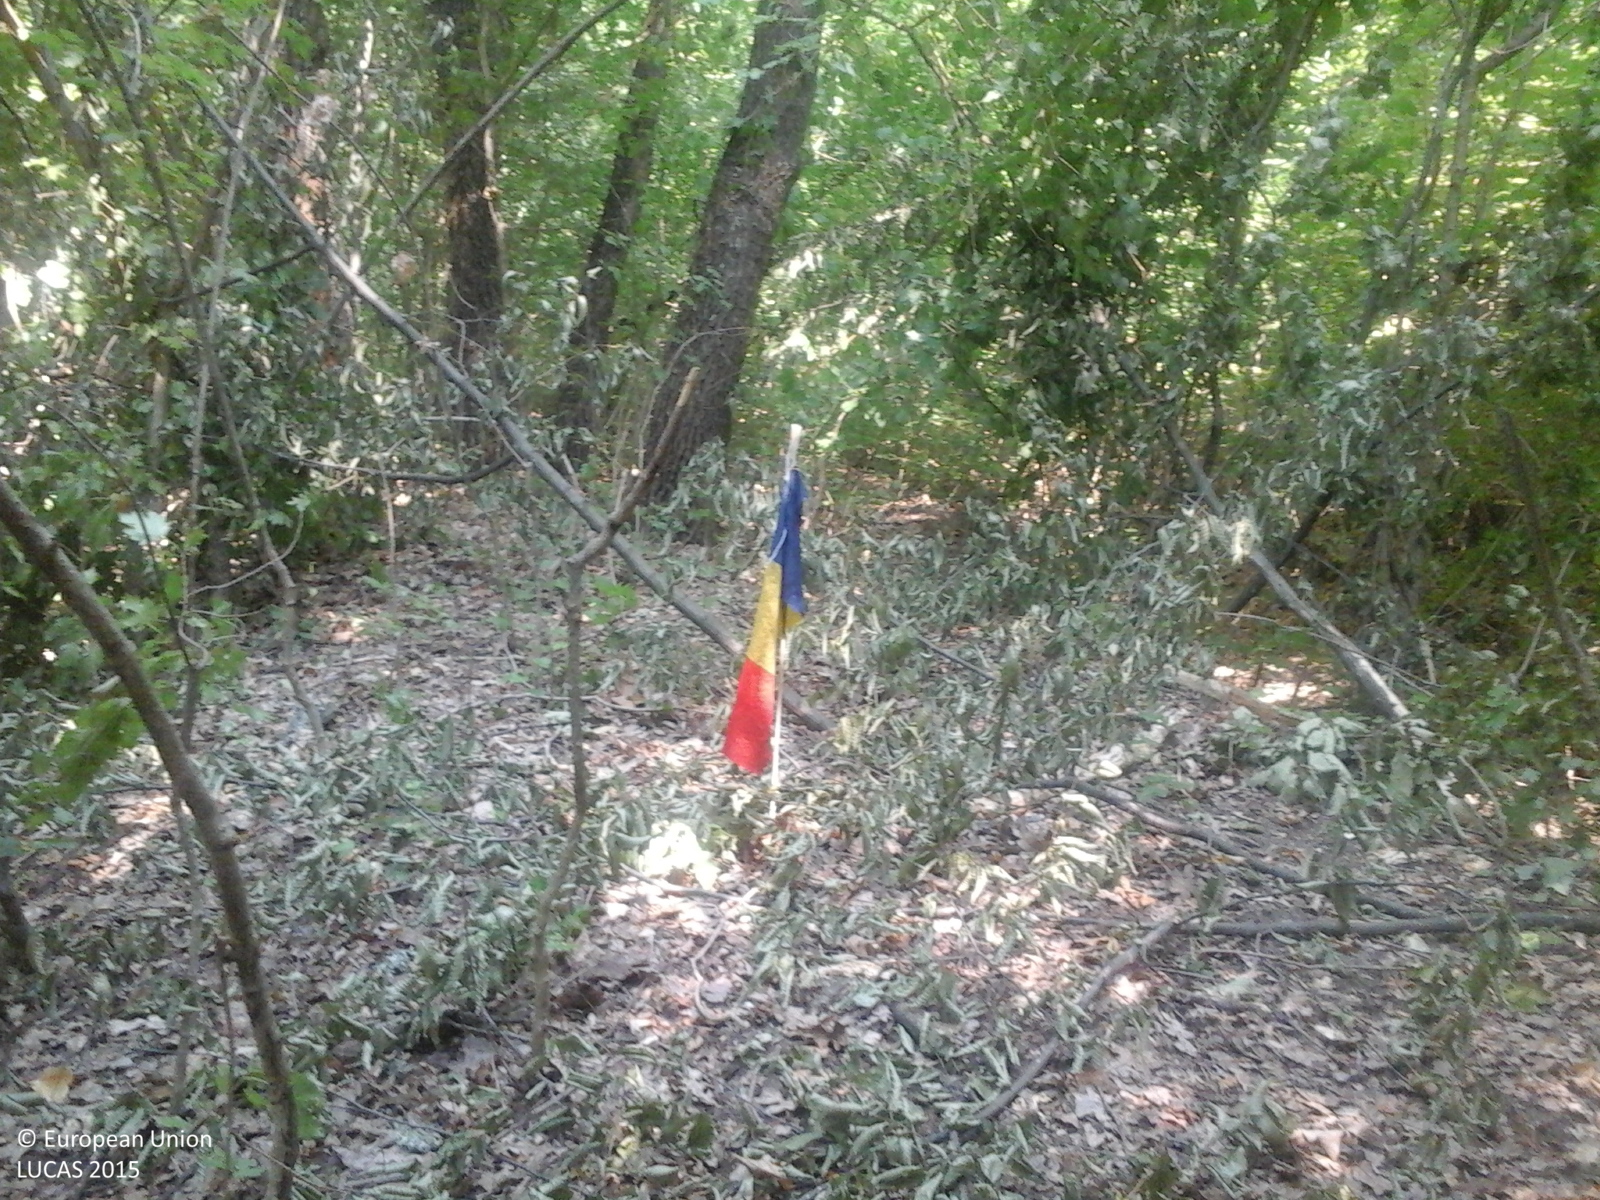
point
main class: Woodland
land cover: Broadleaved woodland
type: acidophilous oak and oak-birch forest
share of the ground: > 75 %
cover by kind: broadleaved forest trees 100 %
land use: Forestry
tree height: > 5 m
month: July
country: RO
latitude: 46.3910
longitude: 27.5770
